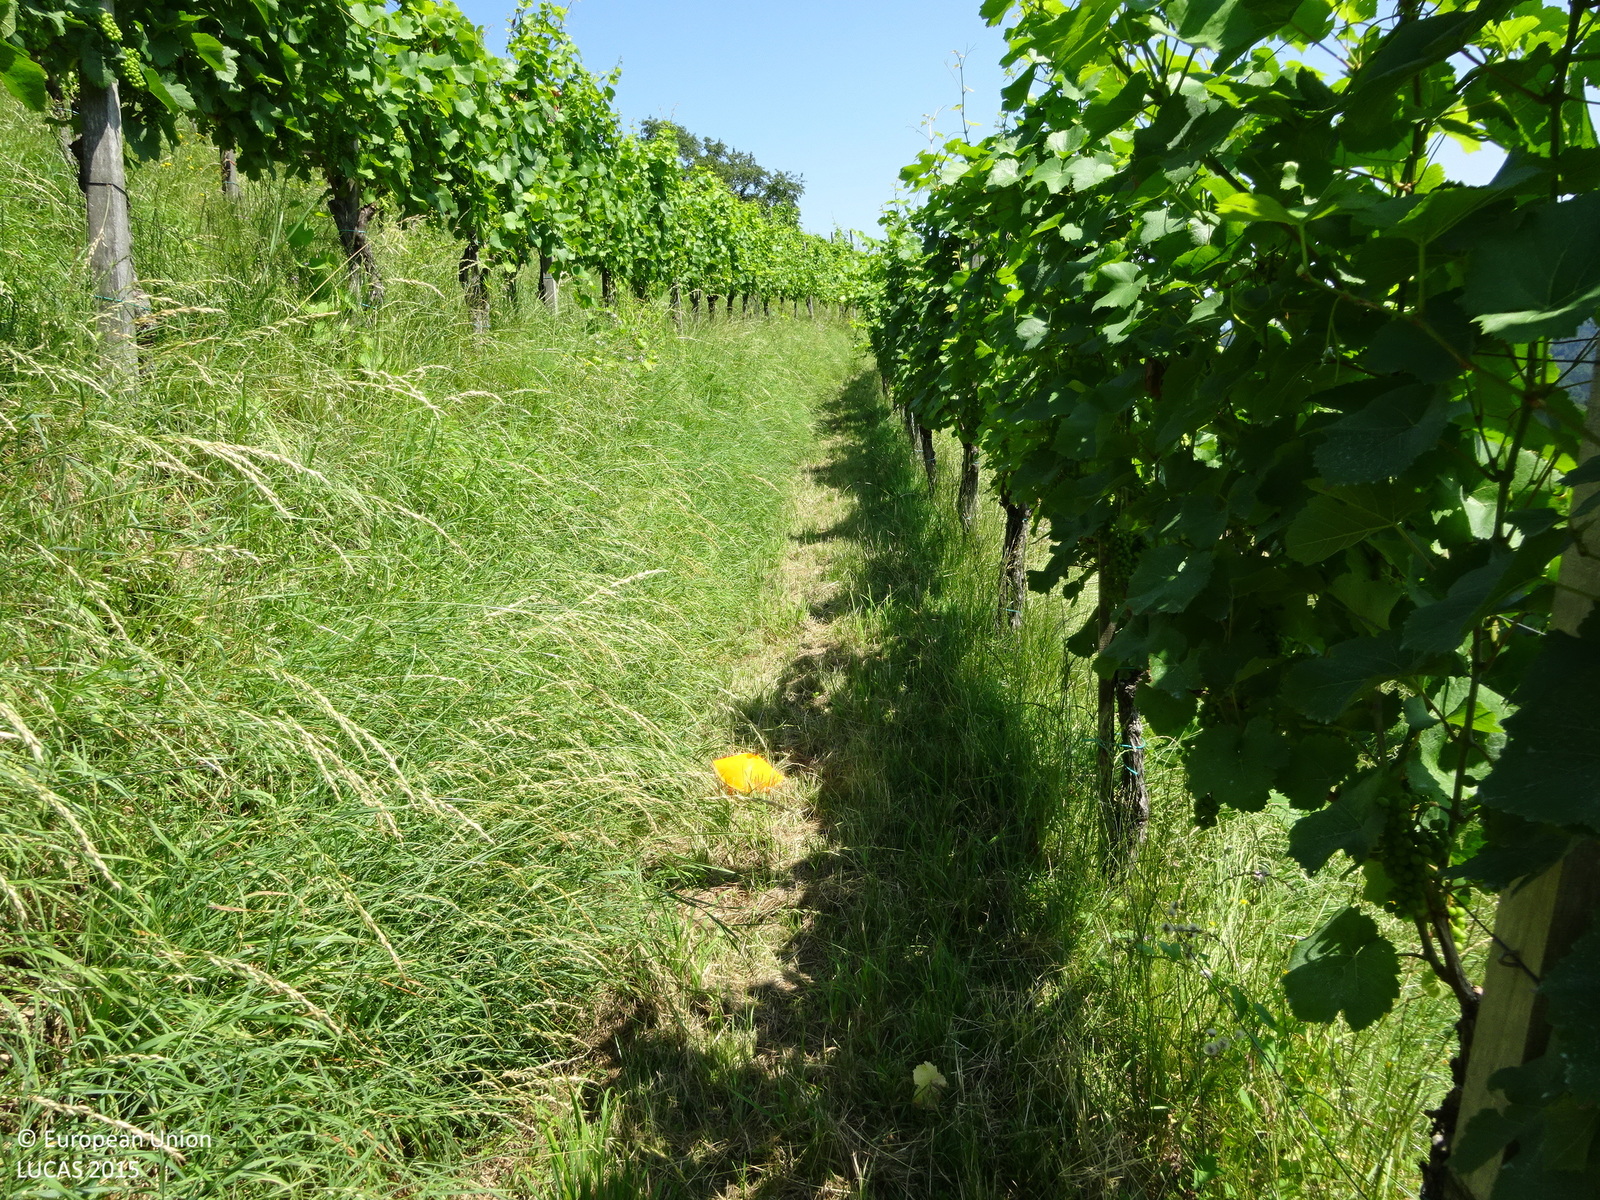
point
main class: Cropland
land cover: Vineyards
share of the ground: 25 - 50 %
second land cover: Grassland without tree/shrub cover
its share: 50 - 75 %
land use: Agriculture (excluding fallow land and kitchen gardens)
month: July
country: AT
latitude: 46.7892
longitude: 15.4619
